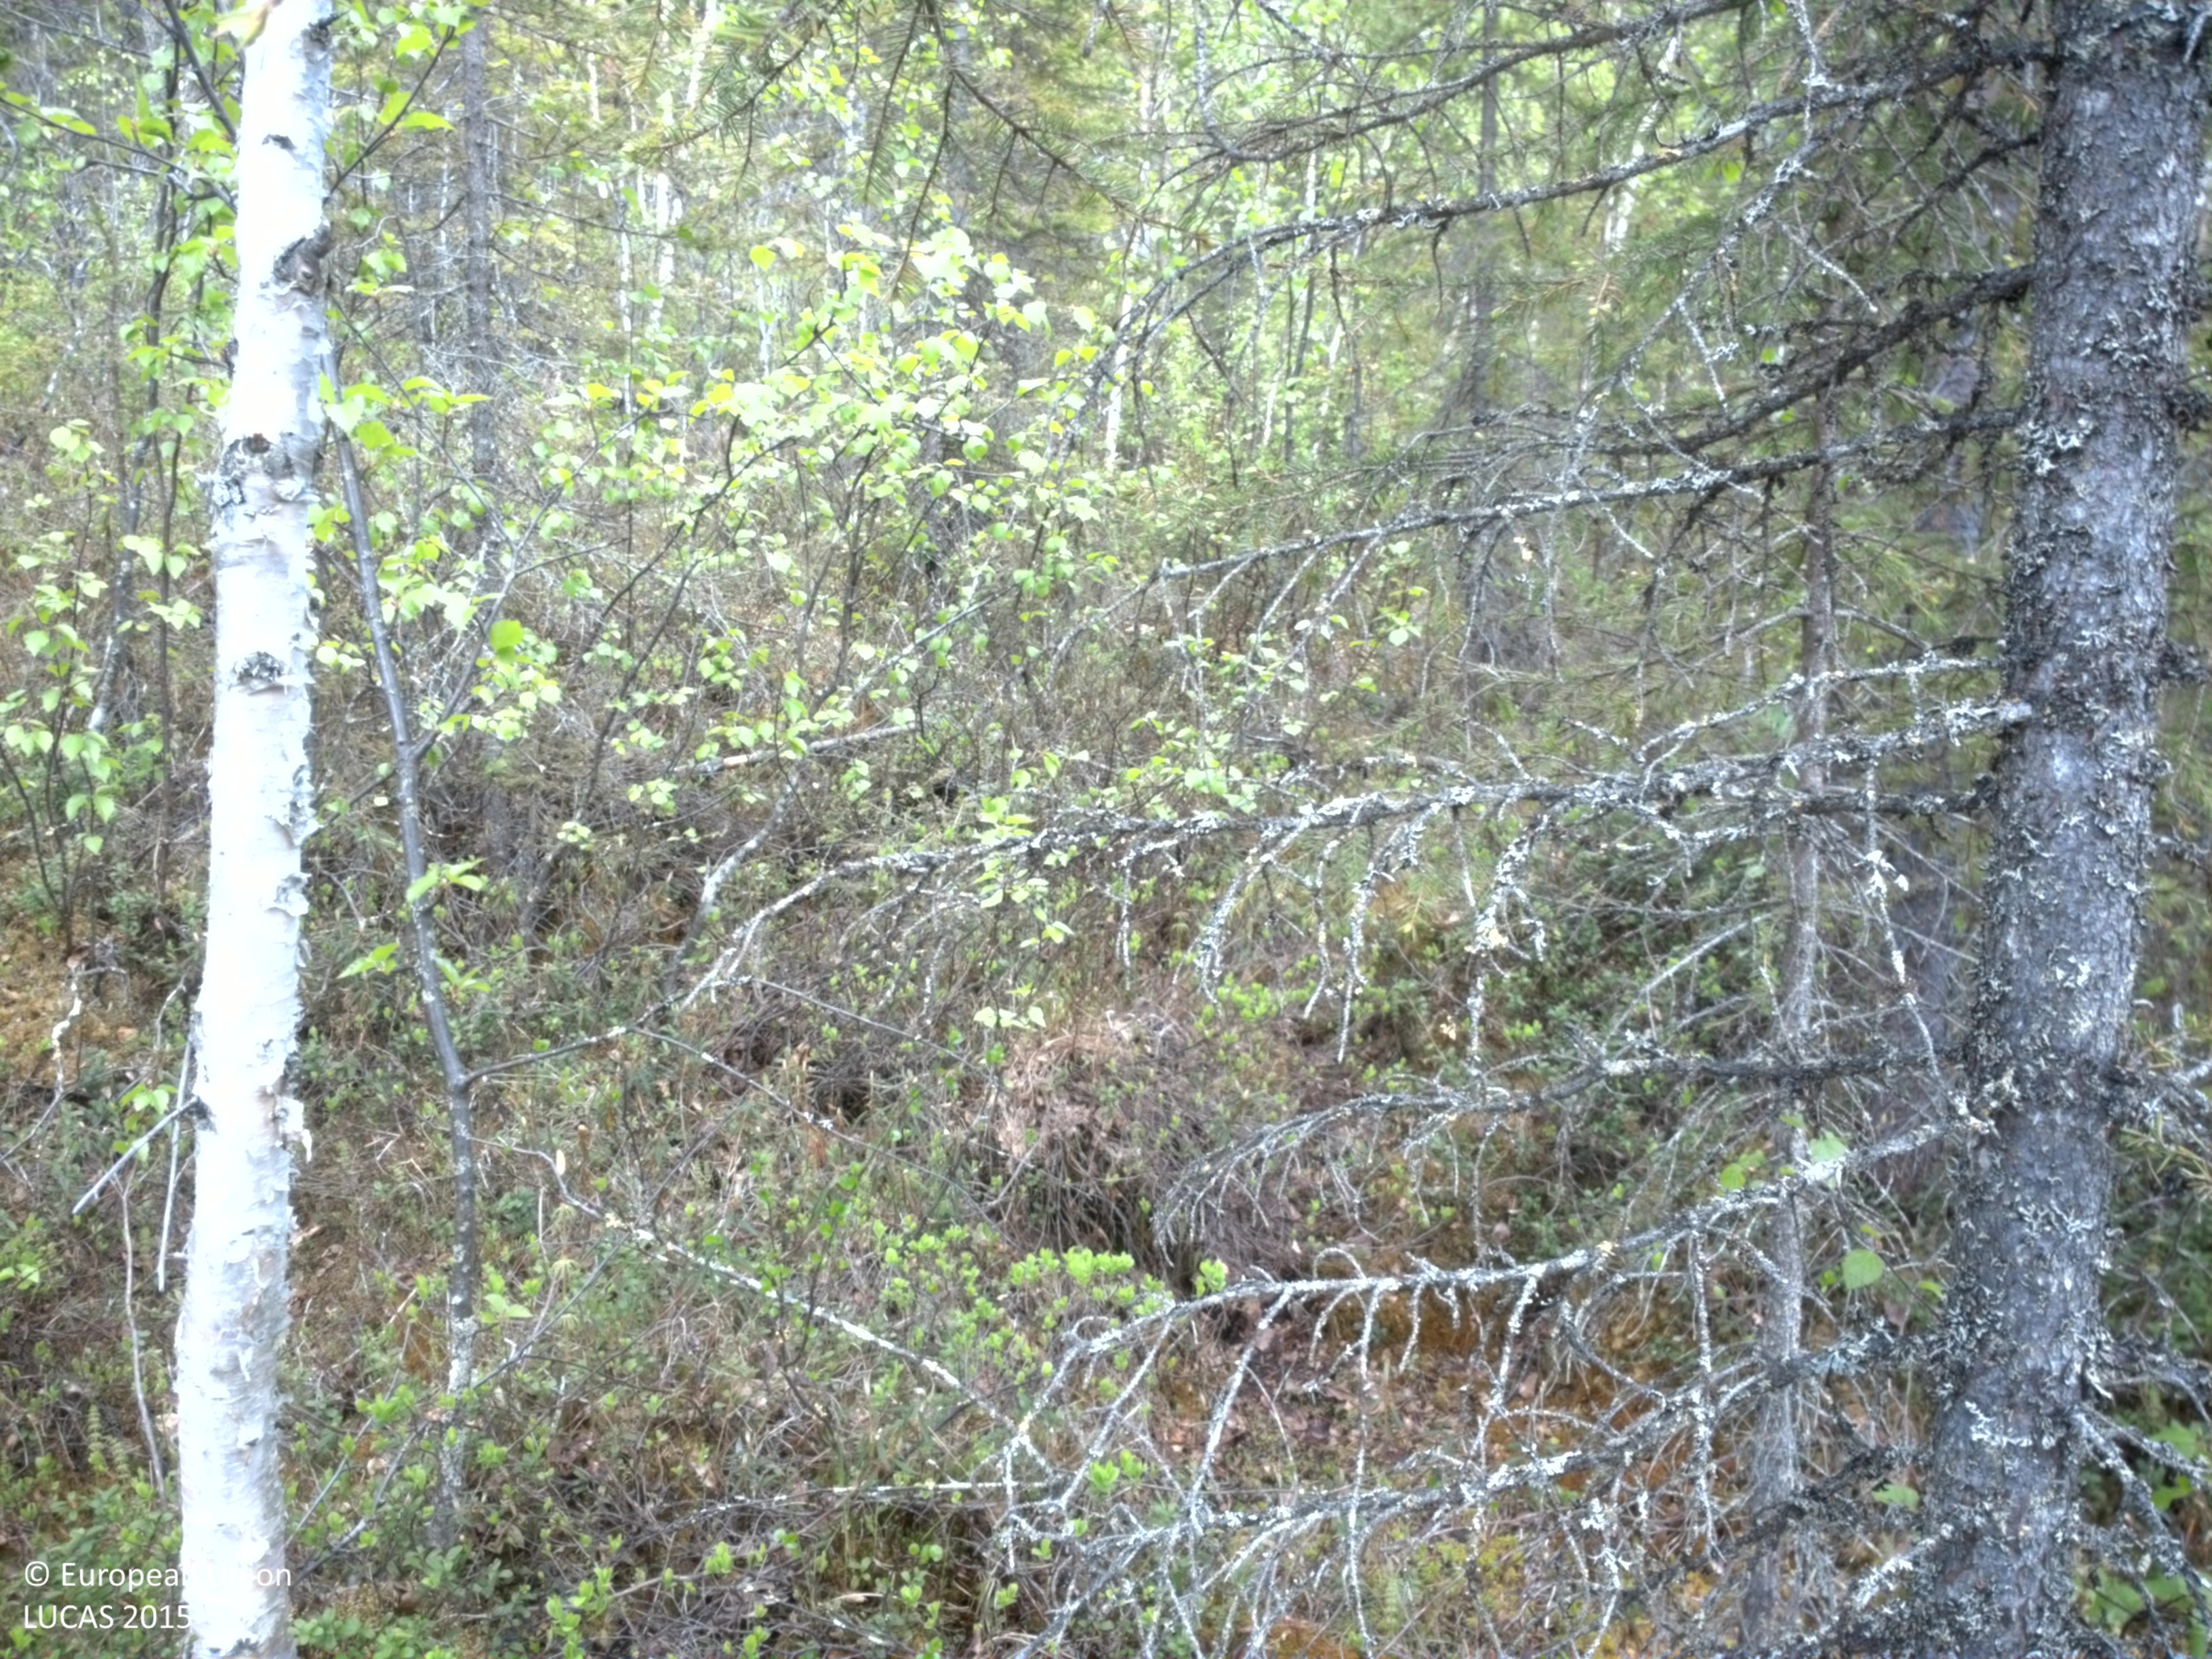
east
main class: Woodland
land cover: Other mixed woodland
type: boreal forest
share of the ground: 50 - 75 %
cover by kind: coniferous forest trees 35 %, shrubs 30 %, broadleaved forest trees 15 %, herbaceous plants 15 %, lichens and mosses 5 %
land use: Forestry
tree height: > 5 m
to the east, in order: Other mixed woodland; Tracks; Other mixed woodland; Rivers and streams; Other mixed woodland; Spruce dominated mixed woodland; Other mixed woodland; Pine dominated coniferous woodland; Pine dominated mixed woodland; Other mixed woodland; Spruce dominated mixed woodland; Other mixed woodland
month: June
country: SE
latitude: 66.7515
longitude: 21.9274
